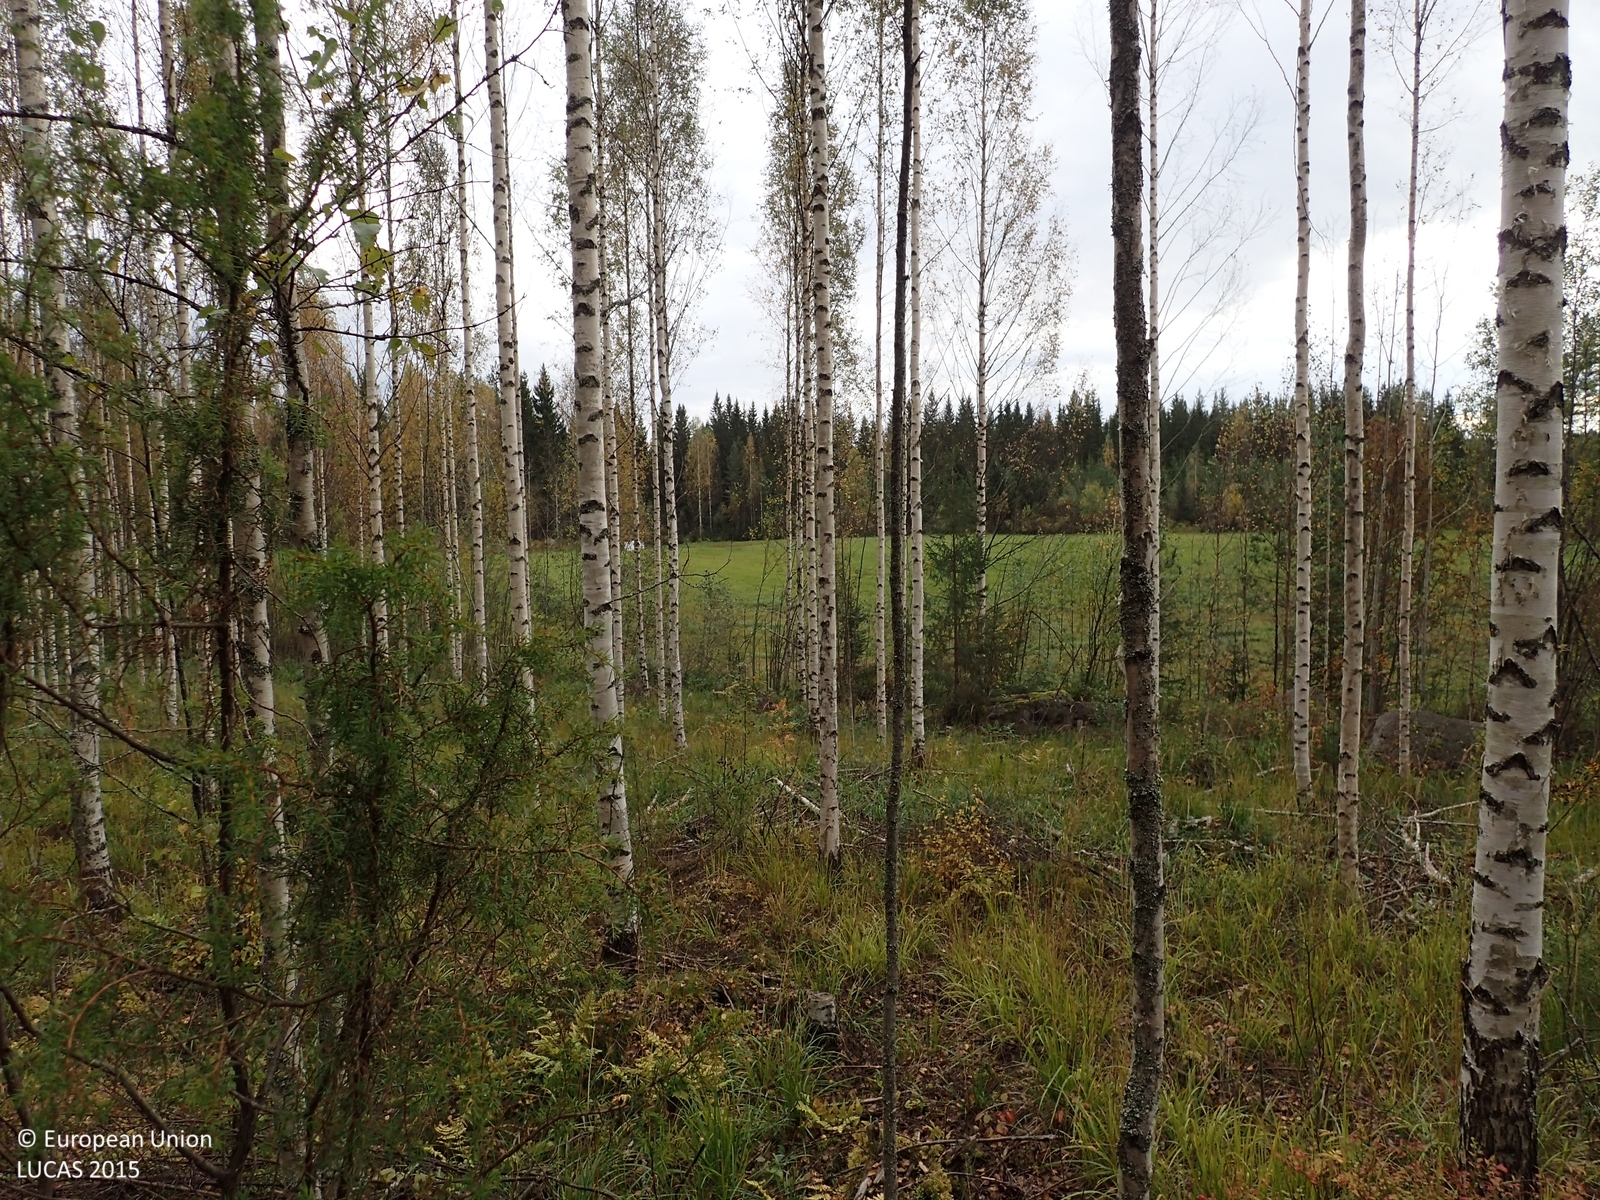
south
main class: Woodland
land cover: Pine dominated mixed woodland
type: boreal forest
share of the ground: > 75 %
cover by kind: coniferous forest trees 60 %, broadleaved forest trees 20 %, shrubs 20 %
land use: Forestry
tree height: > 5 m
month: September
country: FI
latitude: 62.9187
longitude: 26.4540
